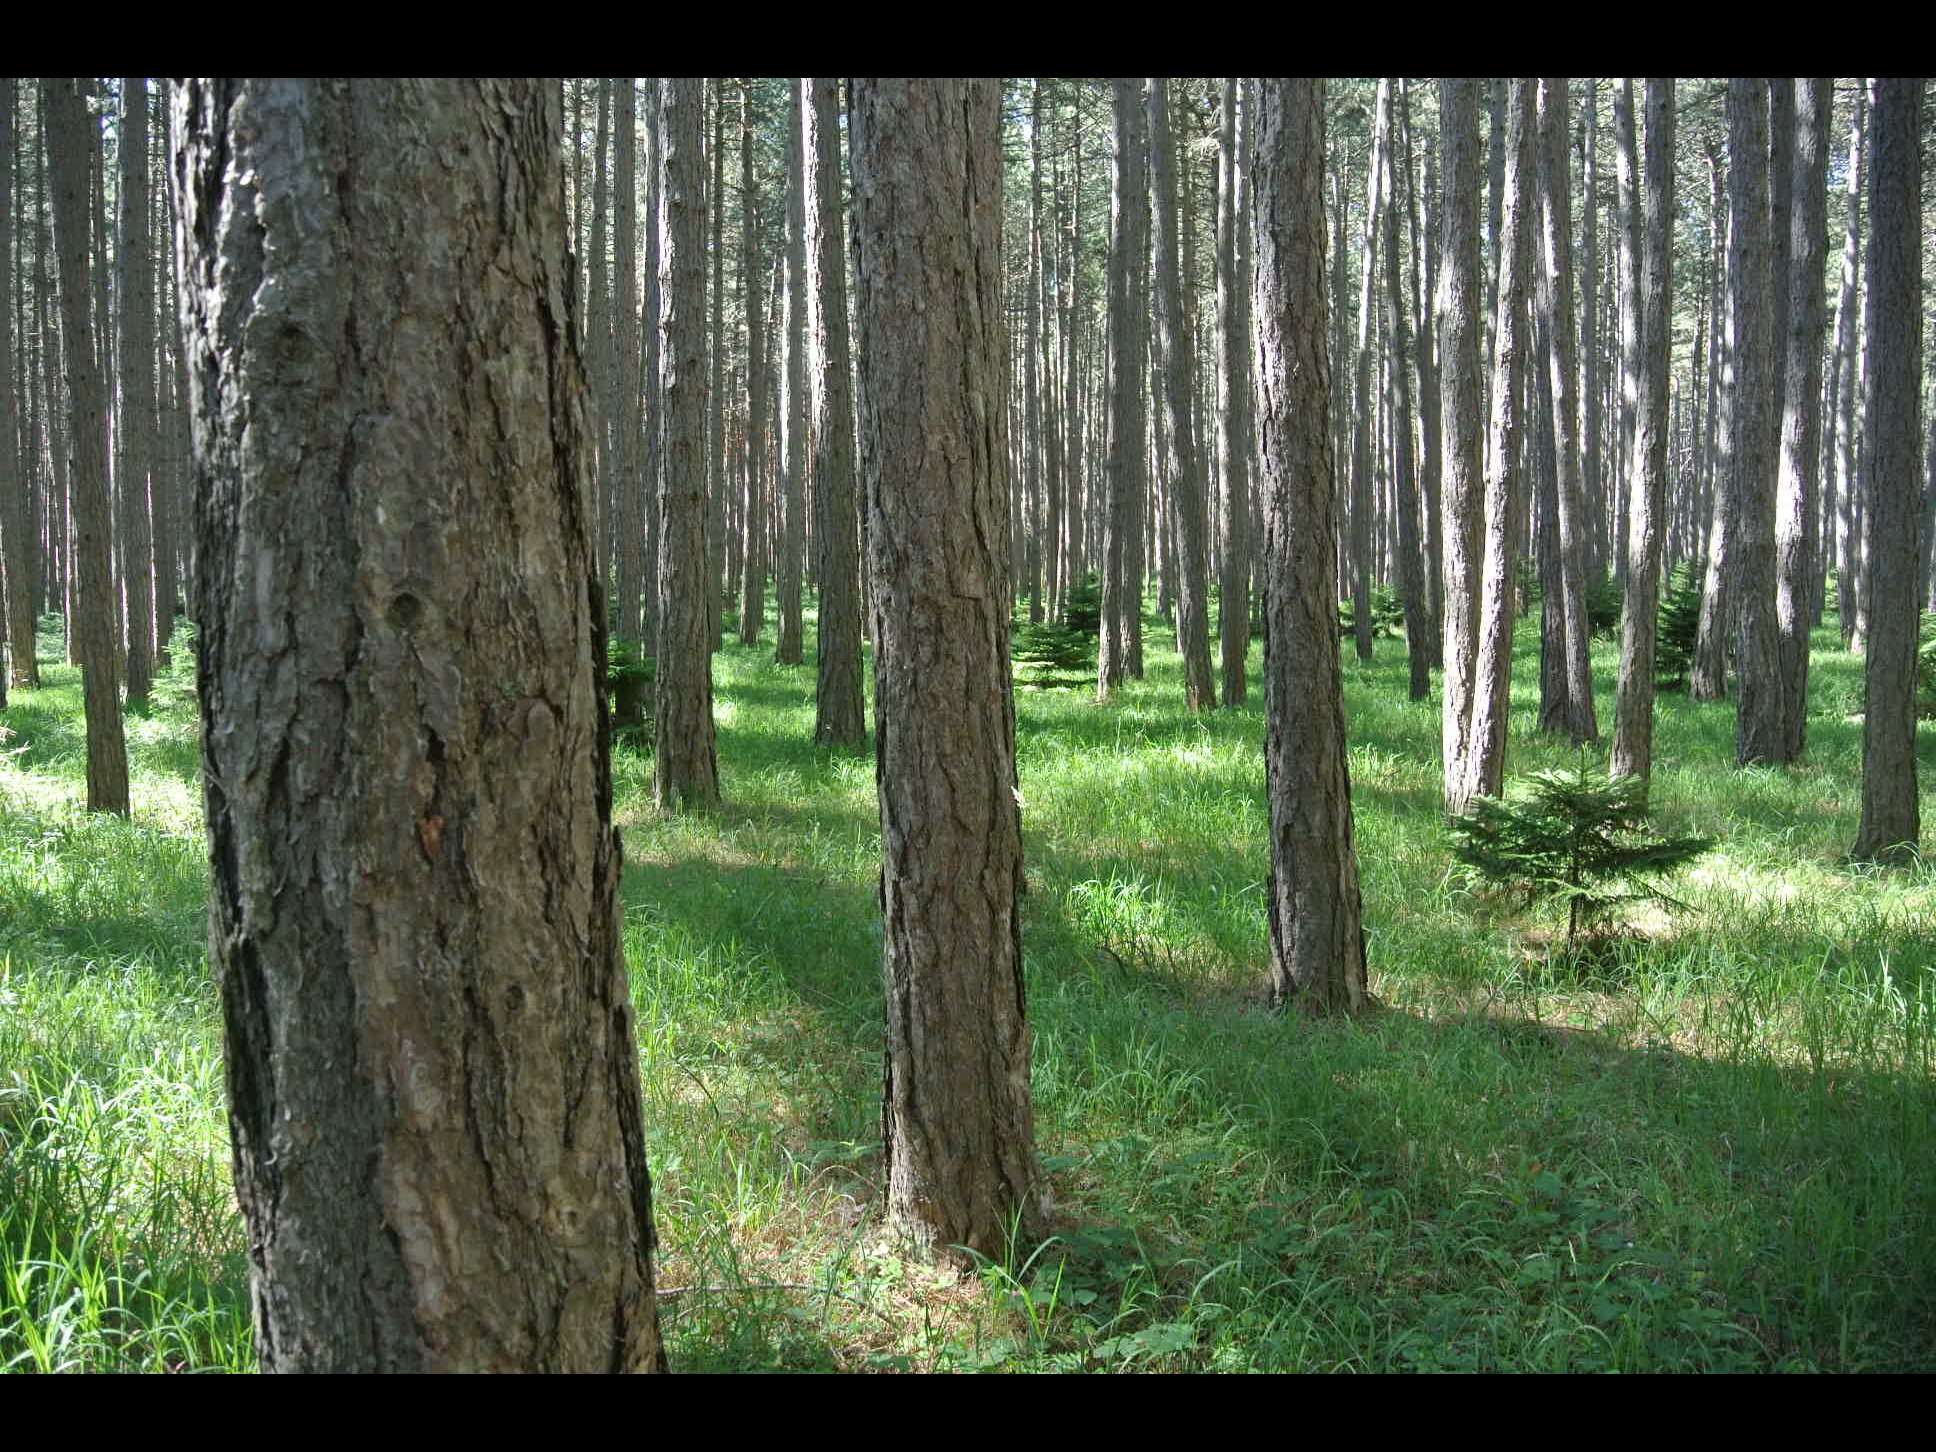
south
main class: Woodland
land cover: Pine dominated coniferous woodland
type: alpine coniferous forest
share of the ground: > 75 %
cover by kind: coniferous forest trees 100 %
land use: Forestry
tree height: > 5 m
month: July
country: AT
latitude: 47.7494
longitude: 16.0719
